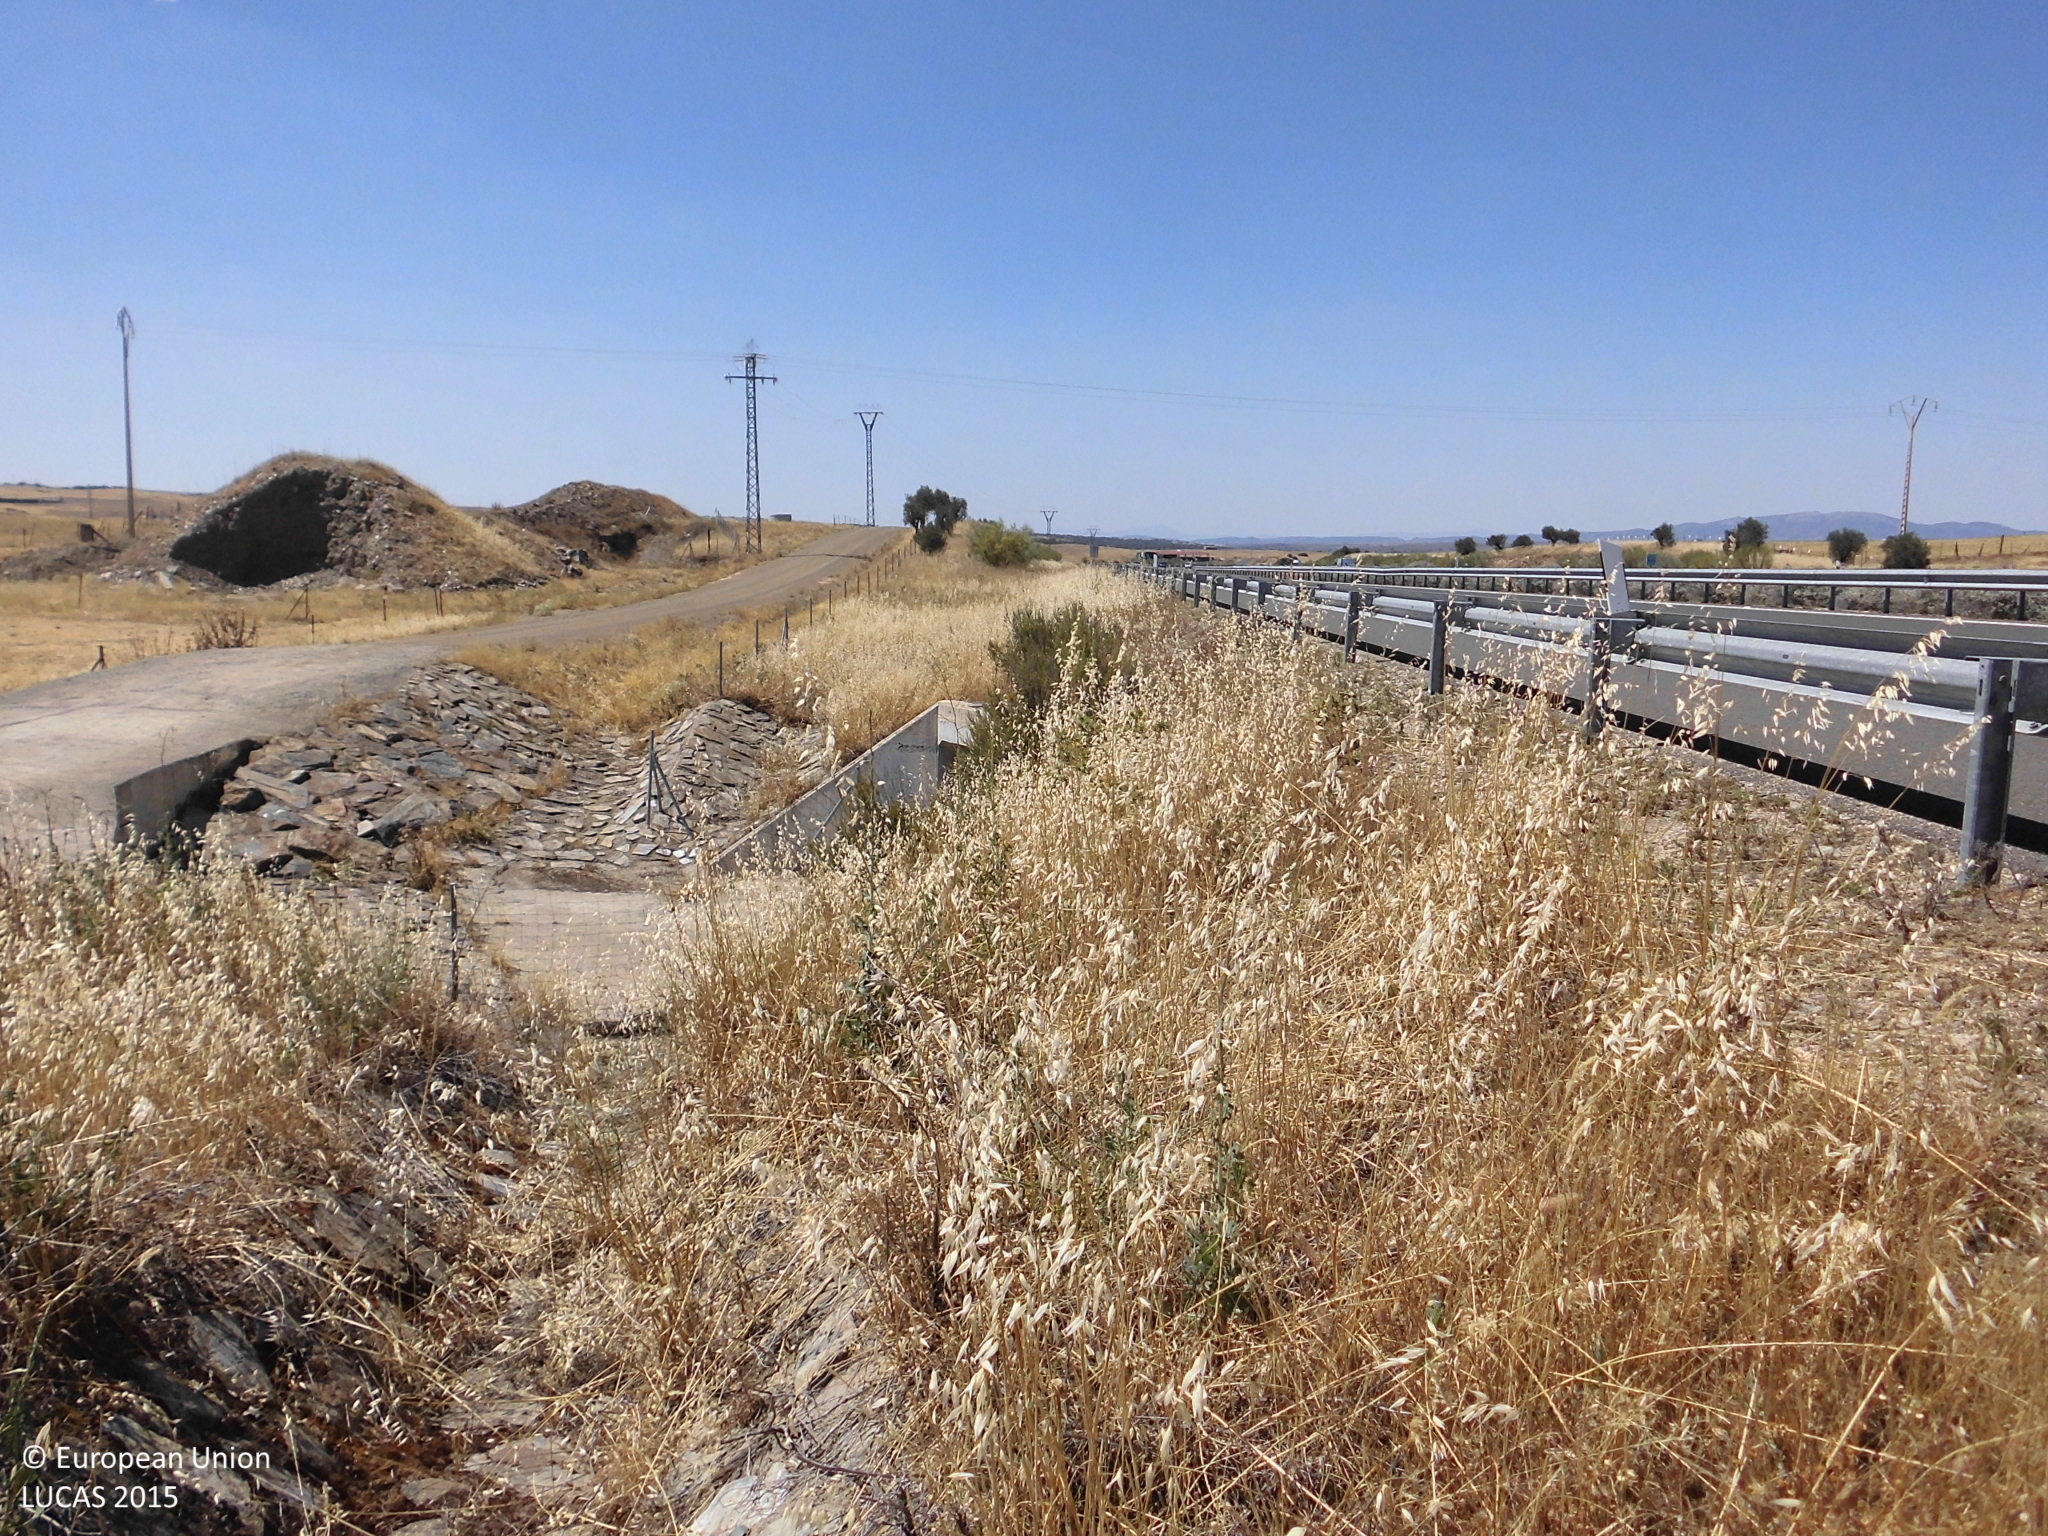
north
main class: Grassland
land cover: Spontaneously vegetated surfaces
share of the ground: 25 - 50 %
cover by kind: consolidated bare surface 75 %, herbaceous plants 25 %
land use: Road transport
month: June
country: ES
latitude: 39.5760
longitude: -6.4035
